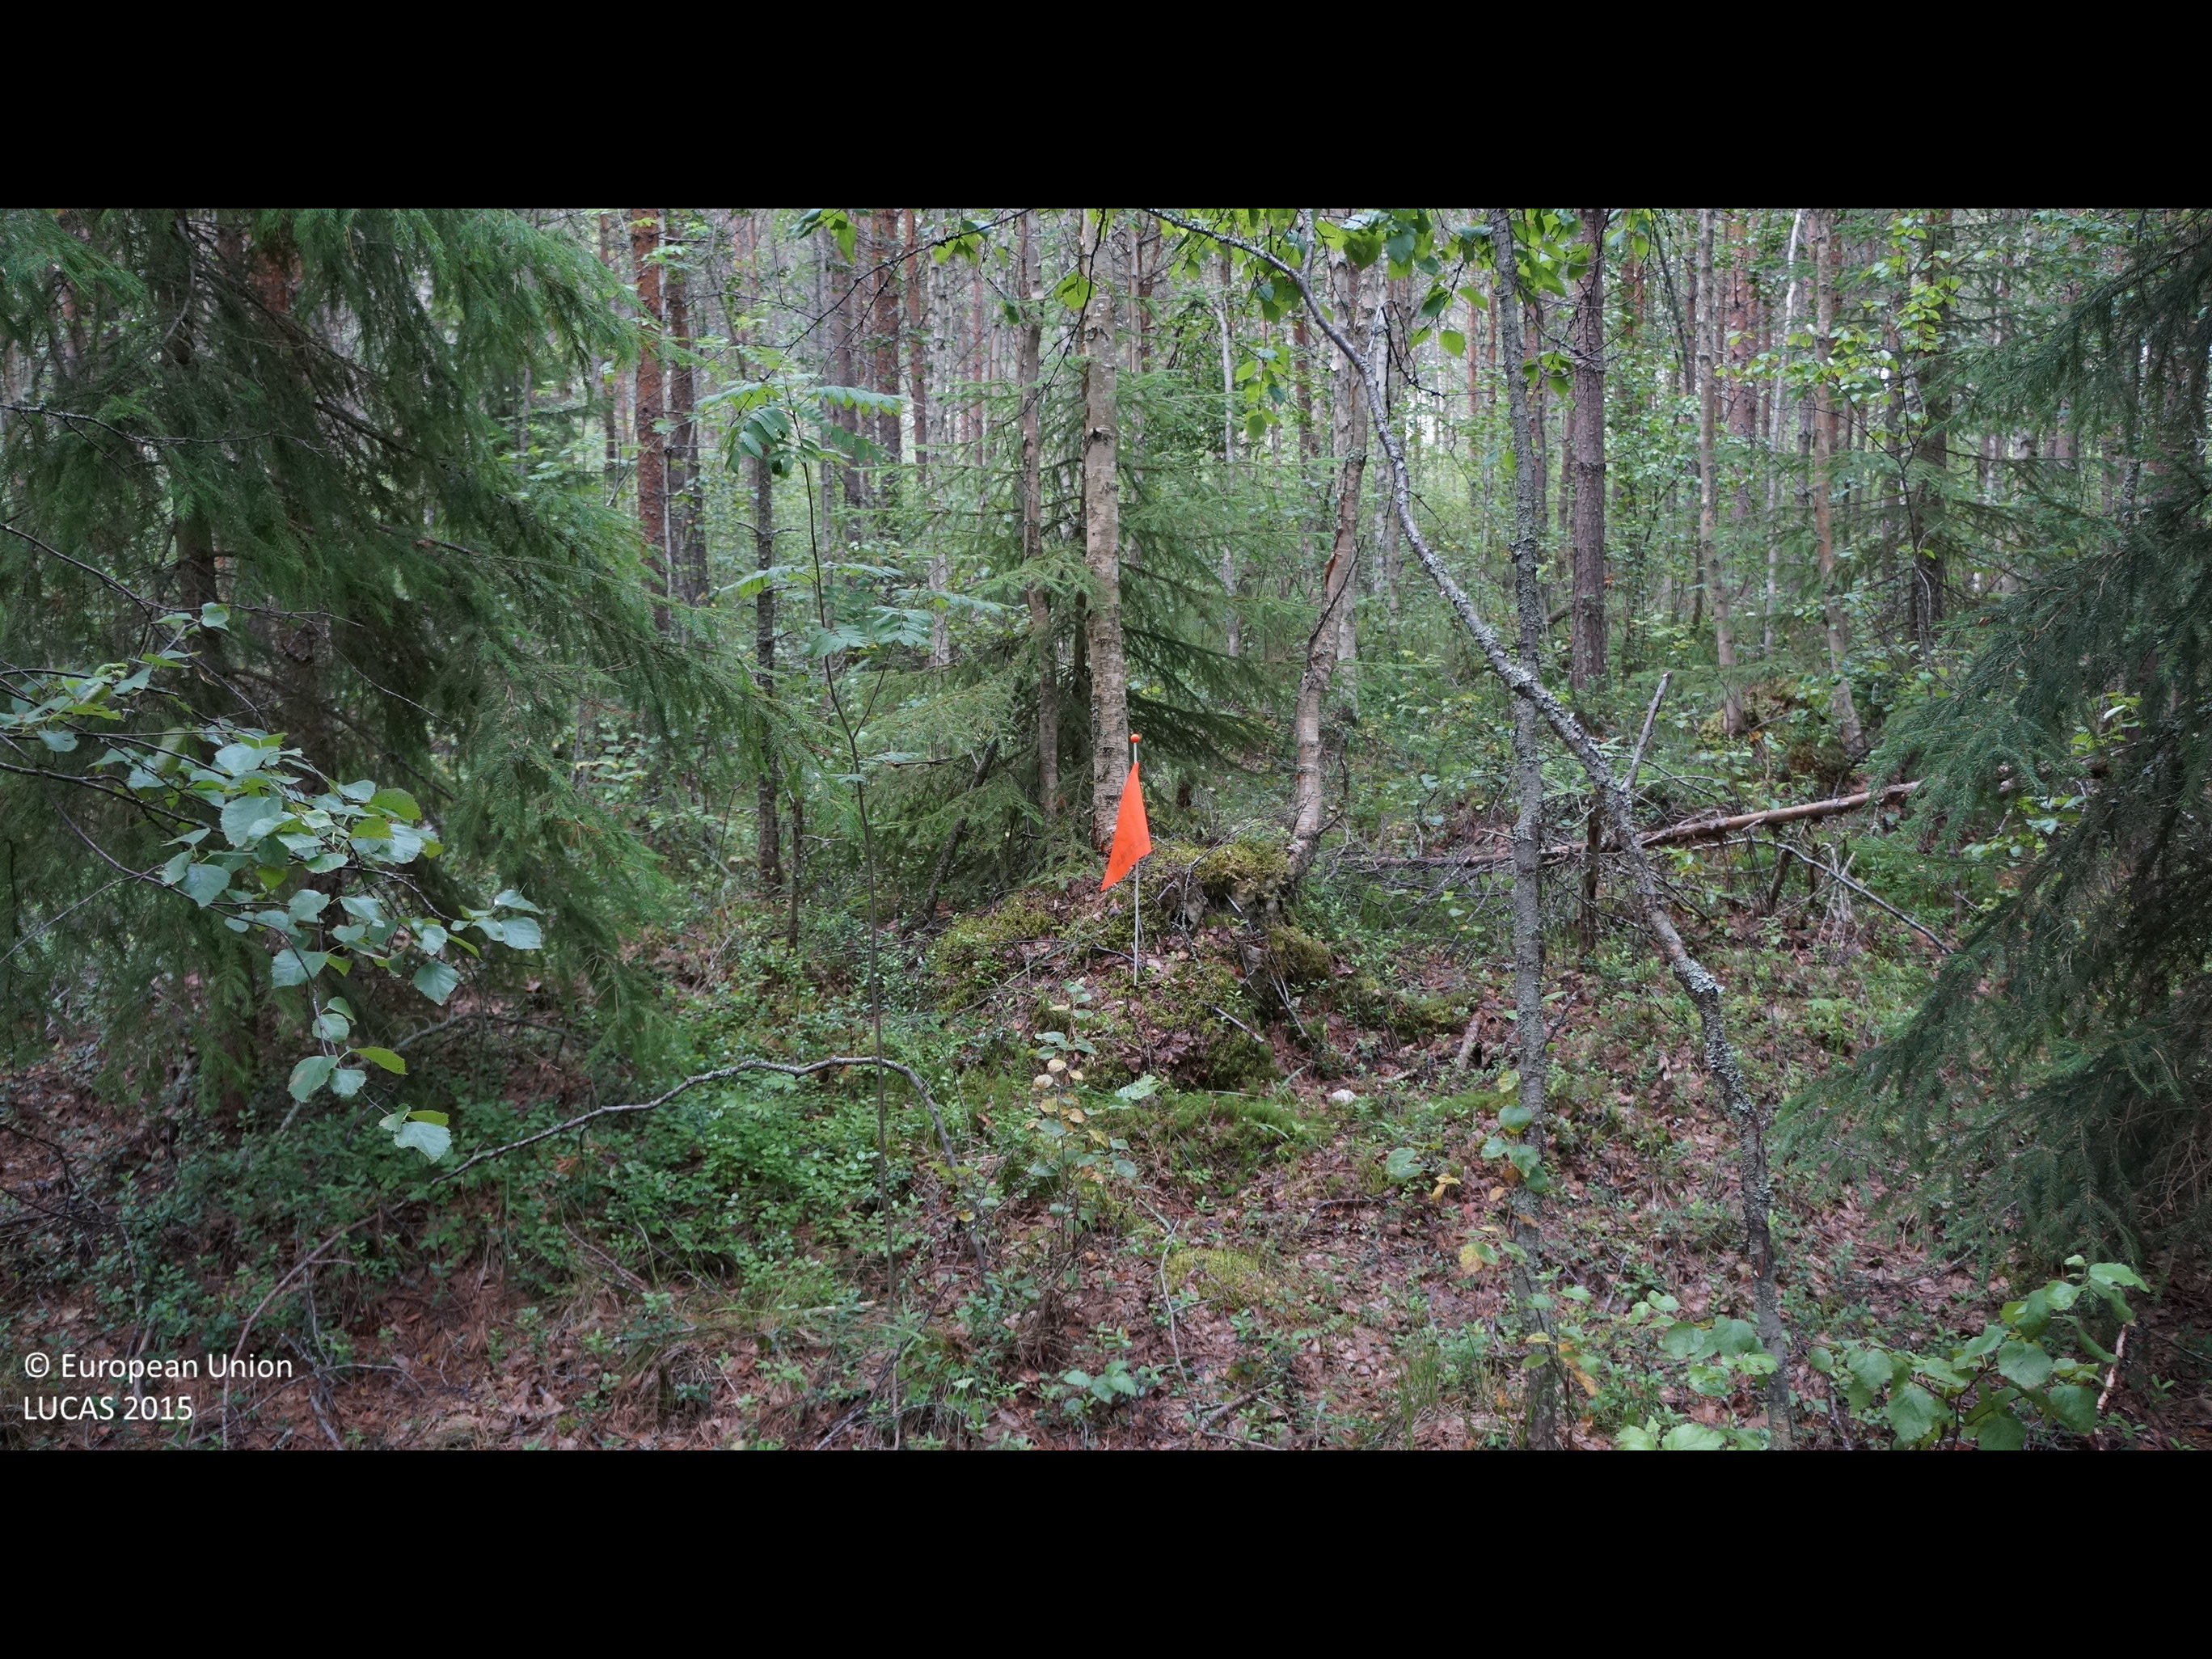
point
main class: Woodland
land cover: Pine dominated mixed woodland
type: boreal forest
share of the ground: > 75 %
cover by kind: broadleaved forest trees 40 %, coniferous forest trees 35 %, shrubs 10 %, lichens and mosses 10 %, herbaceous plants 5 %
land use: Forestry
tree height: > 5 m
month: July
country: FI
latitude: 63.9870
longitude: 24.4821
